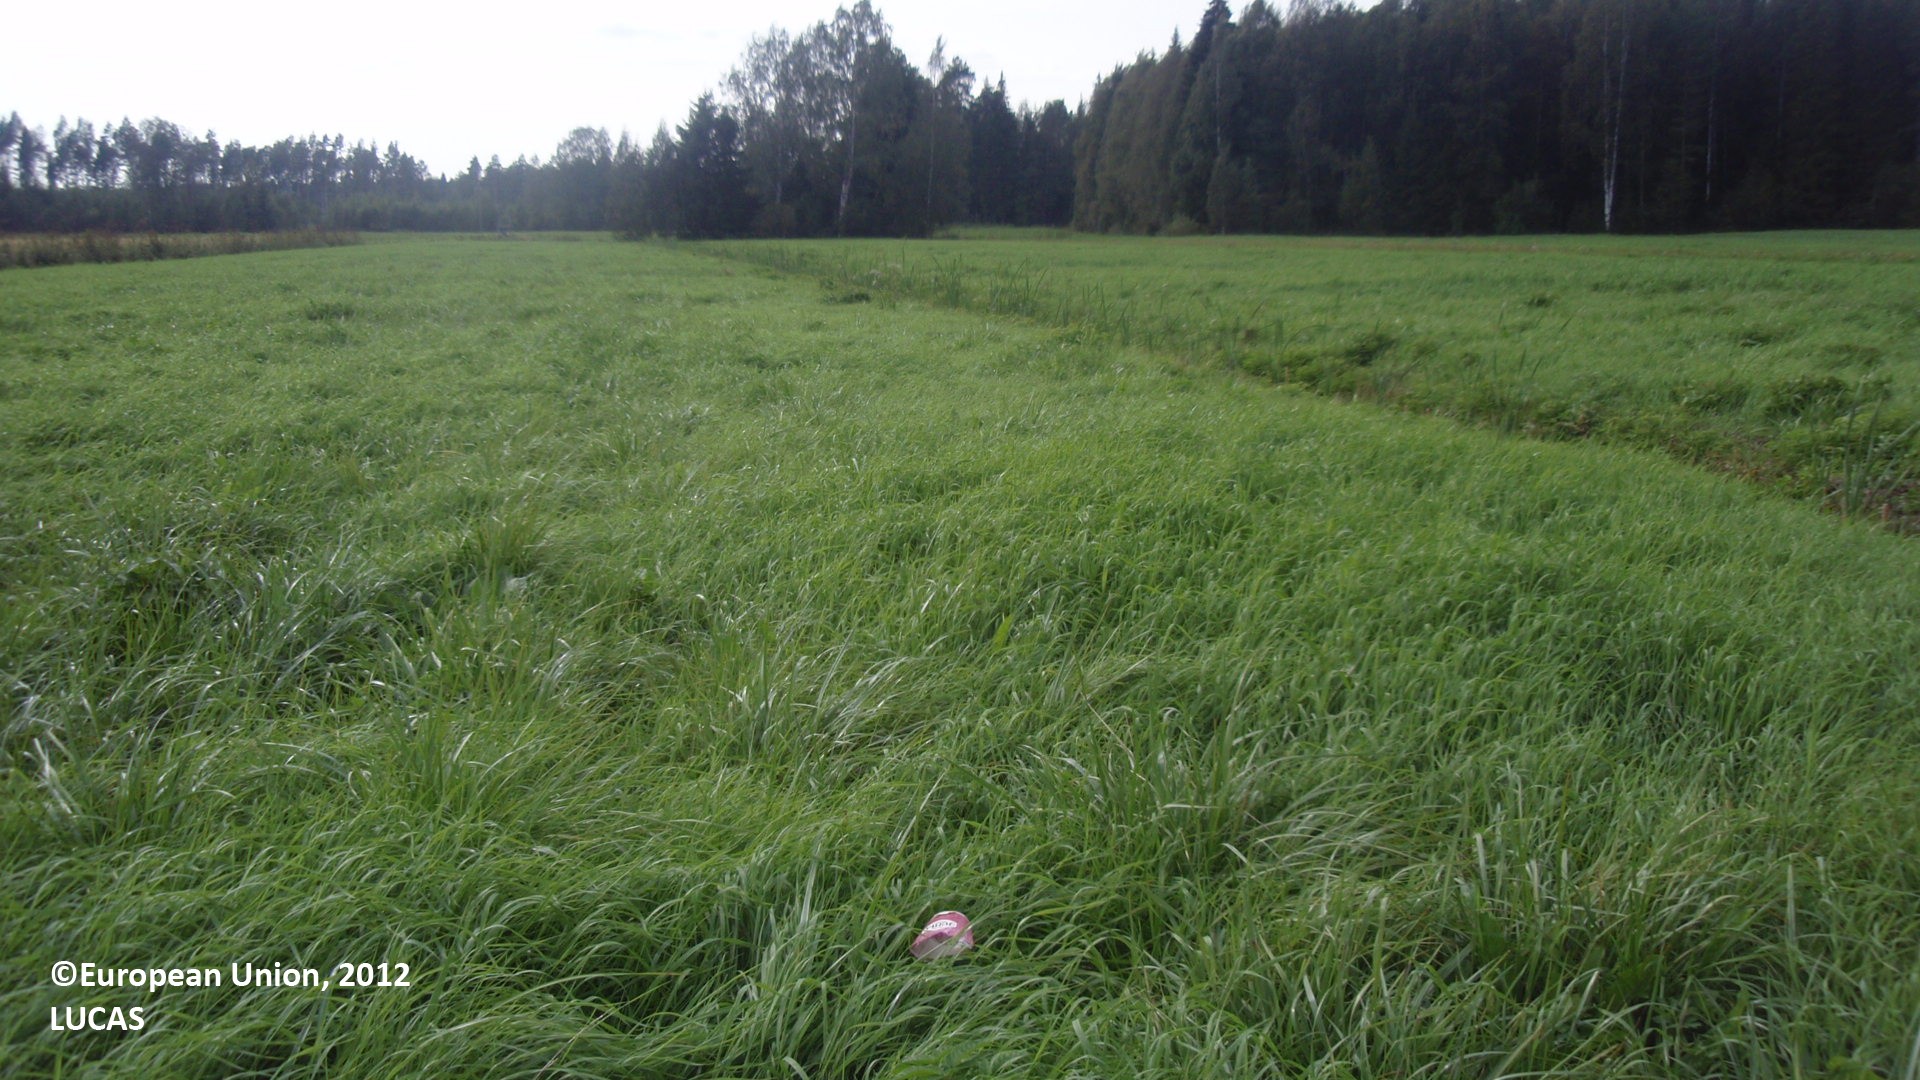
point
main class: Cropland
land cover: Temporary grasslands
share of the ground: > 75 %
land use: Agriculture (excluding fallow land and kitchen gardens)
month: August
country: FI
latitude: 60.8291
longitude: 27.2245
